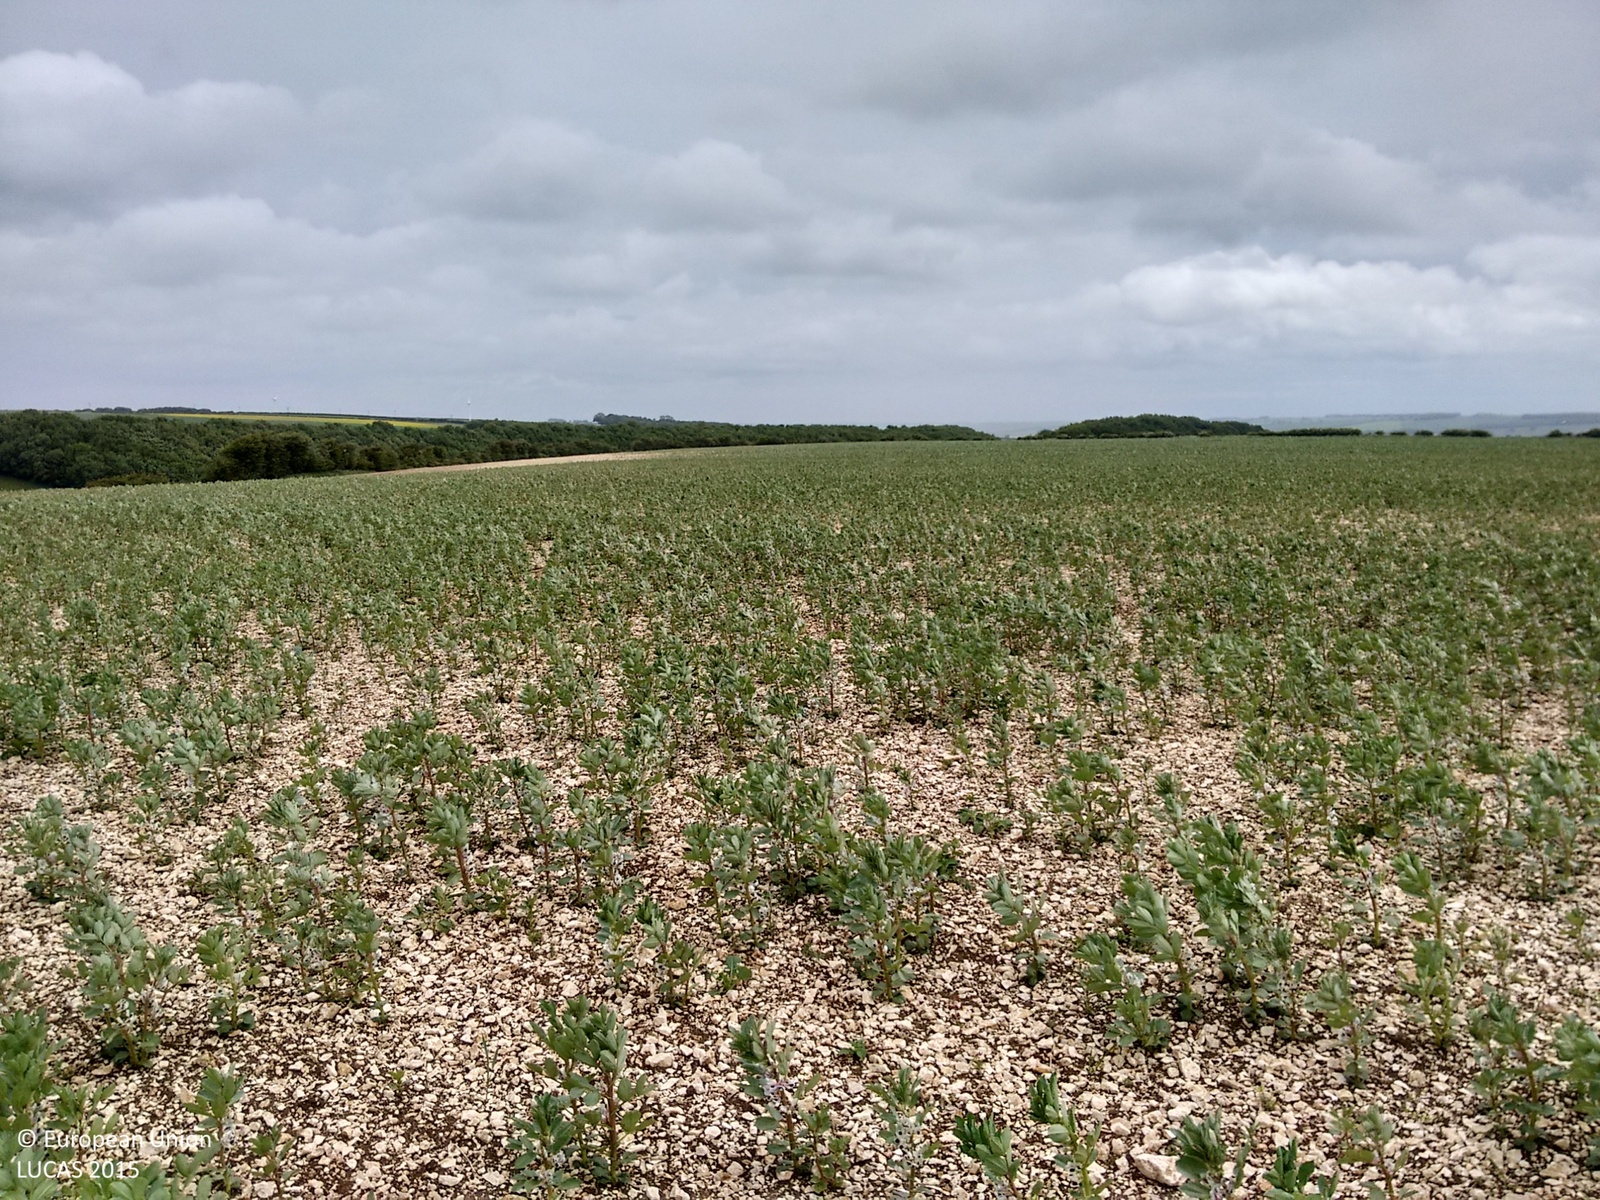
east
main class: Cropland
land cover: Dry pulses
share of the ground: 10 - 25 %
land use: Agriculture (excluding fallow land and kitchen gardens)
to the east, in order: Dry pulses; Grass margins; Managed hedges; Fences; Spontaneously vegetated surfaces
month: June
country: GB
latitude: 54.1597
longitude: -0.4959
